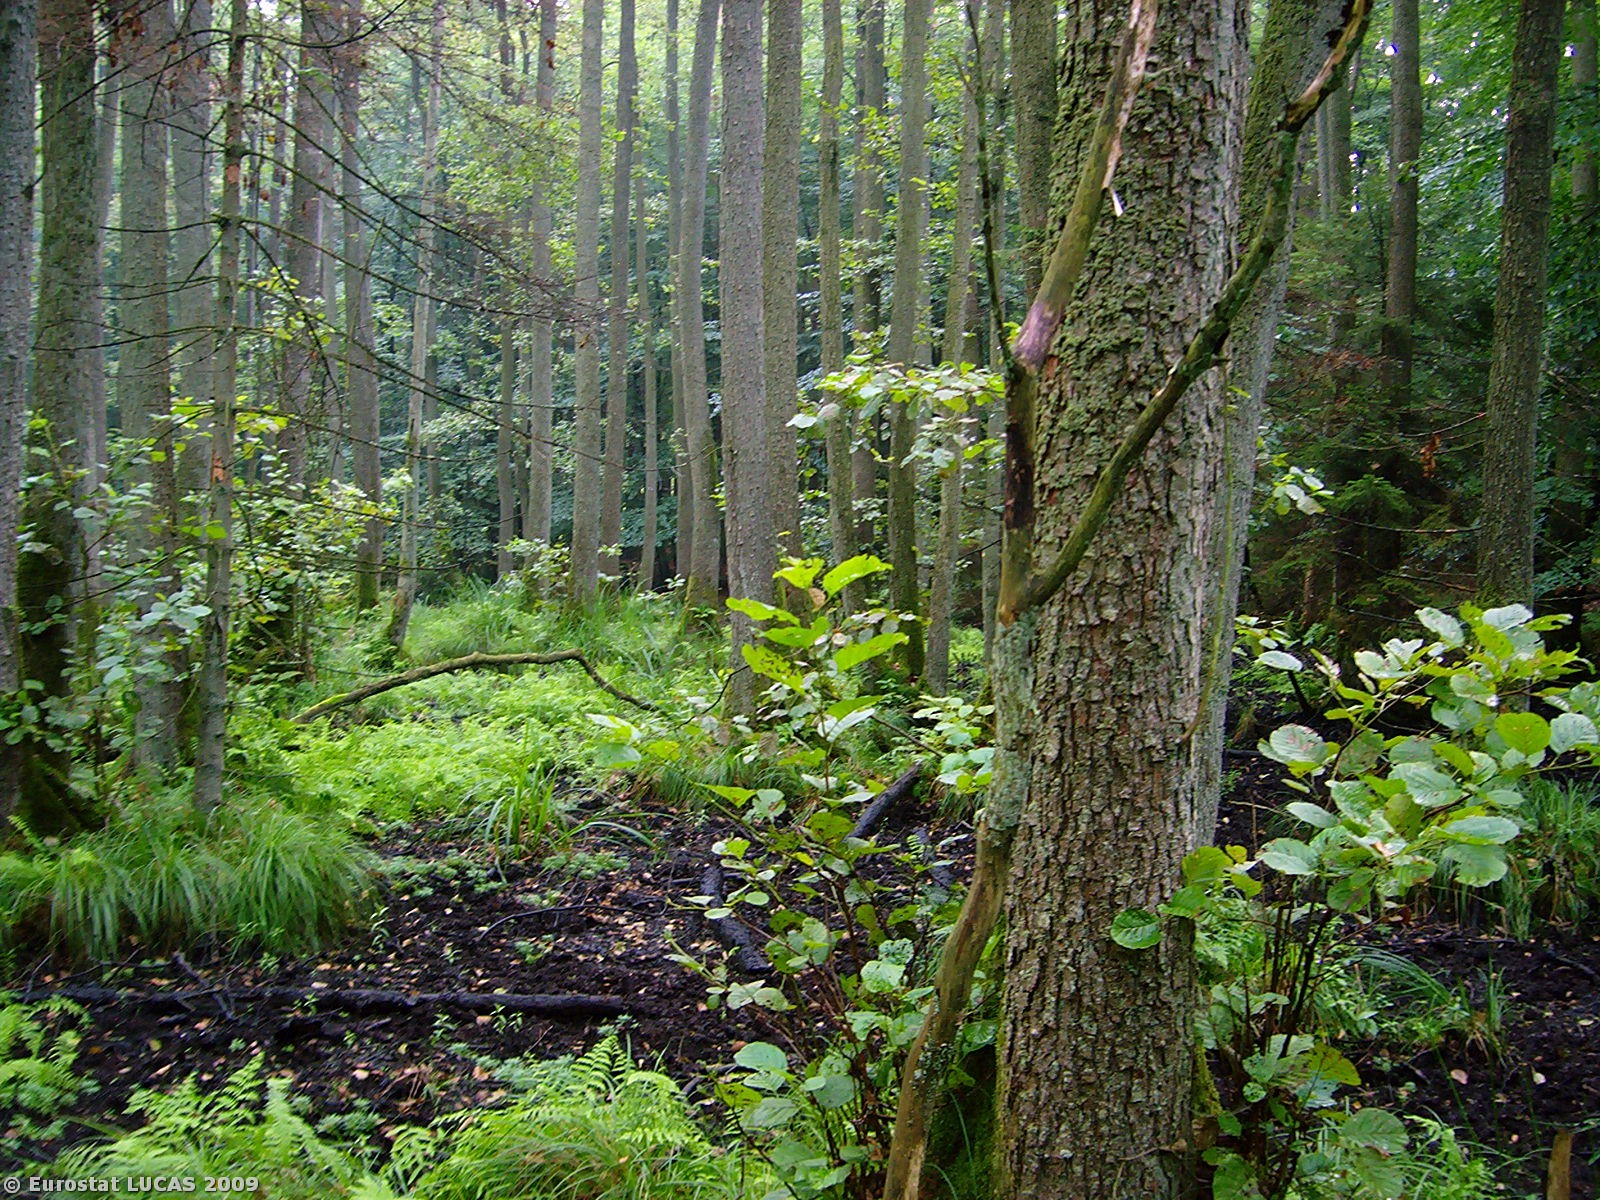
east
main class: Woodland
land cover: Broadleaved woodland
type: mesophytic deciduous forest
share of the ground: > 75 %
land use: Forestry
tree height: > 5 m
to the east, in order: Broadleaved woodland
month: August
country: PL
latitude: 53.5764
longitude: 14.3352
